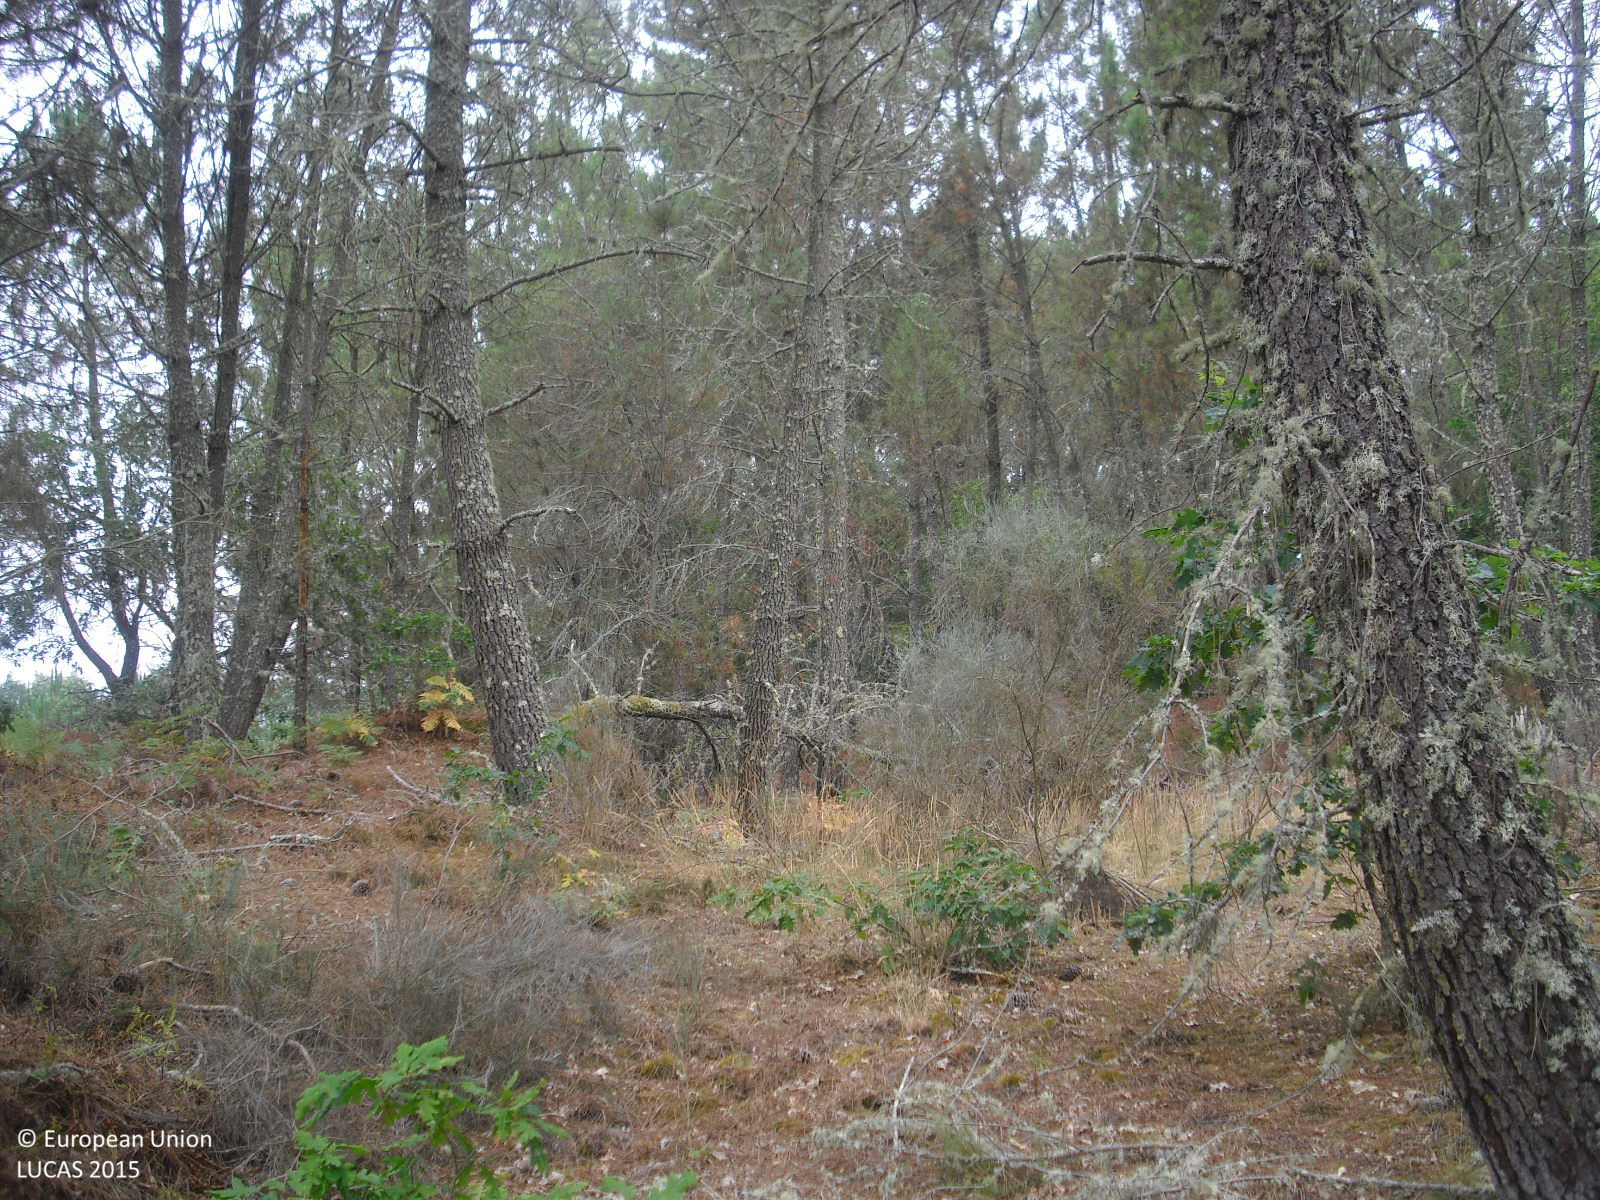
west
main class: Woodland
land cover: Pine dominated mixed woodland
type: hemiboreal forest and nemoral coniferous forest and mixed broadleaved-coniferous forest
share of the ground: 50 - 75 %
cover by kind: shrubs 65 %, coniferous forest trees 20 %, broadleaved forest trees 15 %
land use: Forestry
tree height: > 5 m
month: July
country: ES
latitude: 42.3950
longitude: -7.7753
